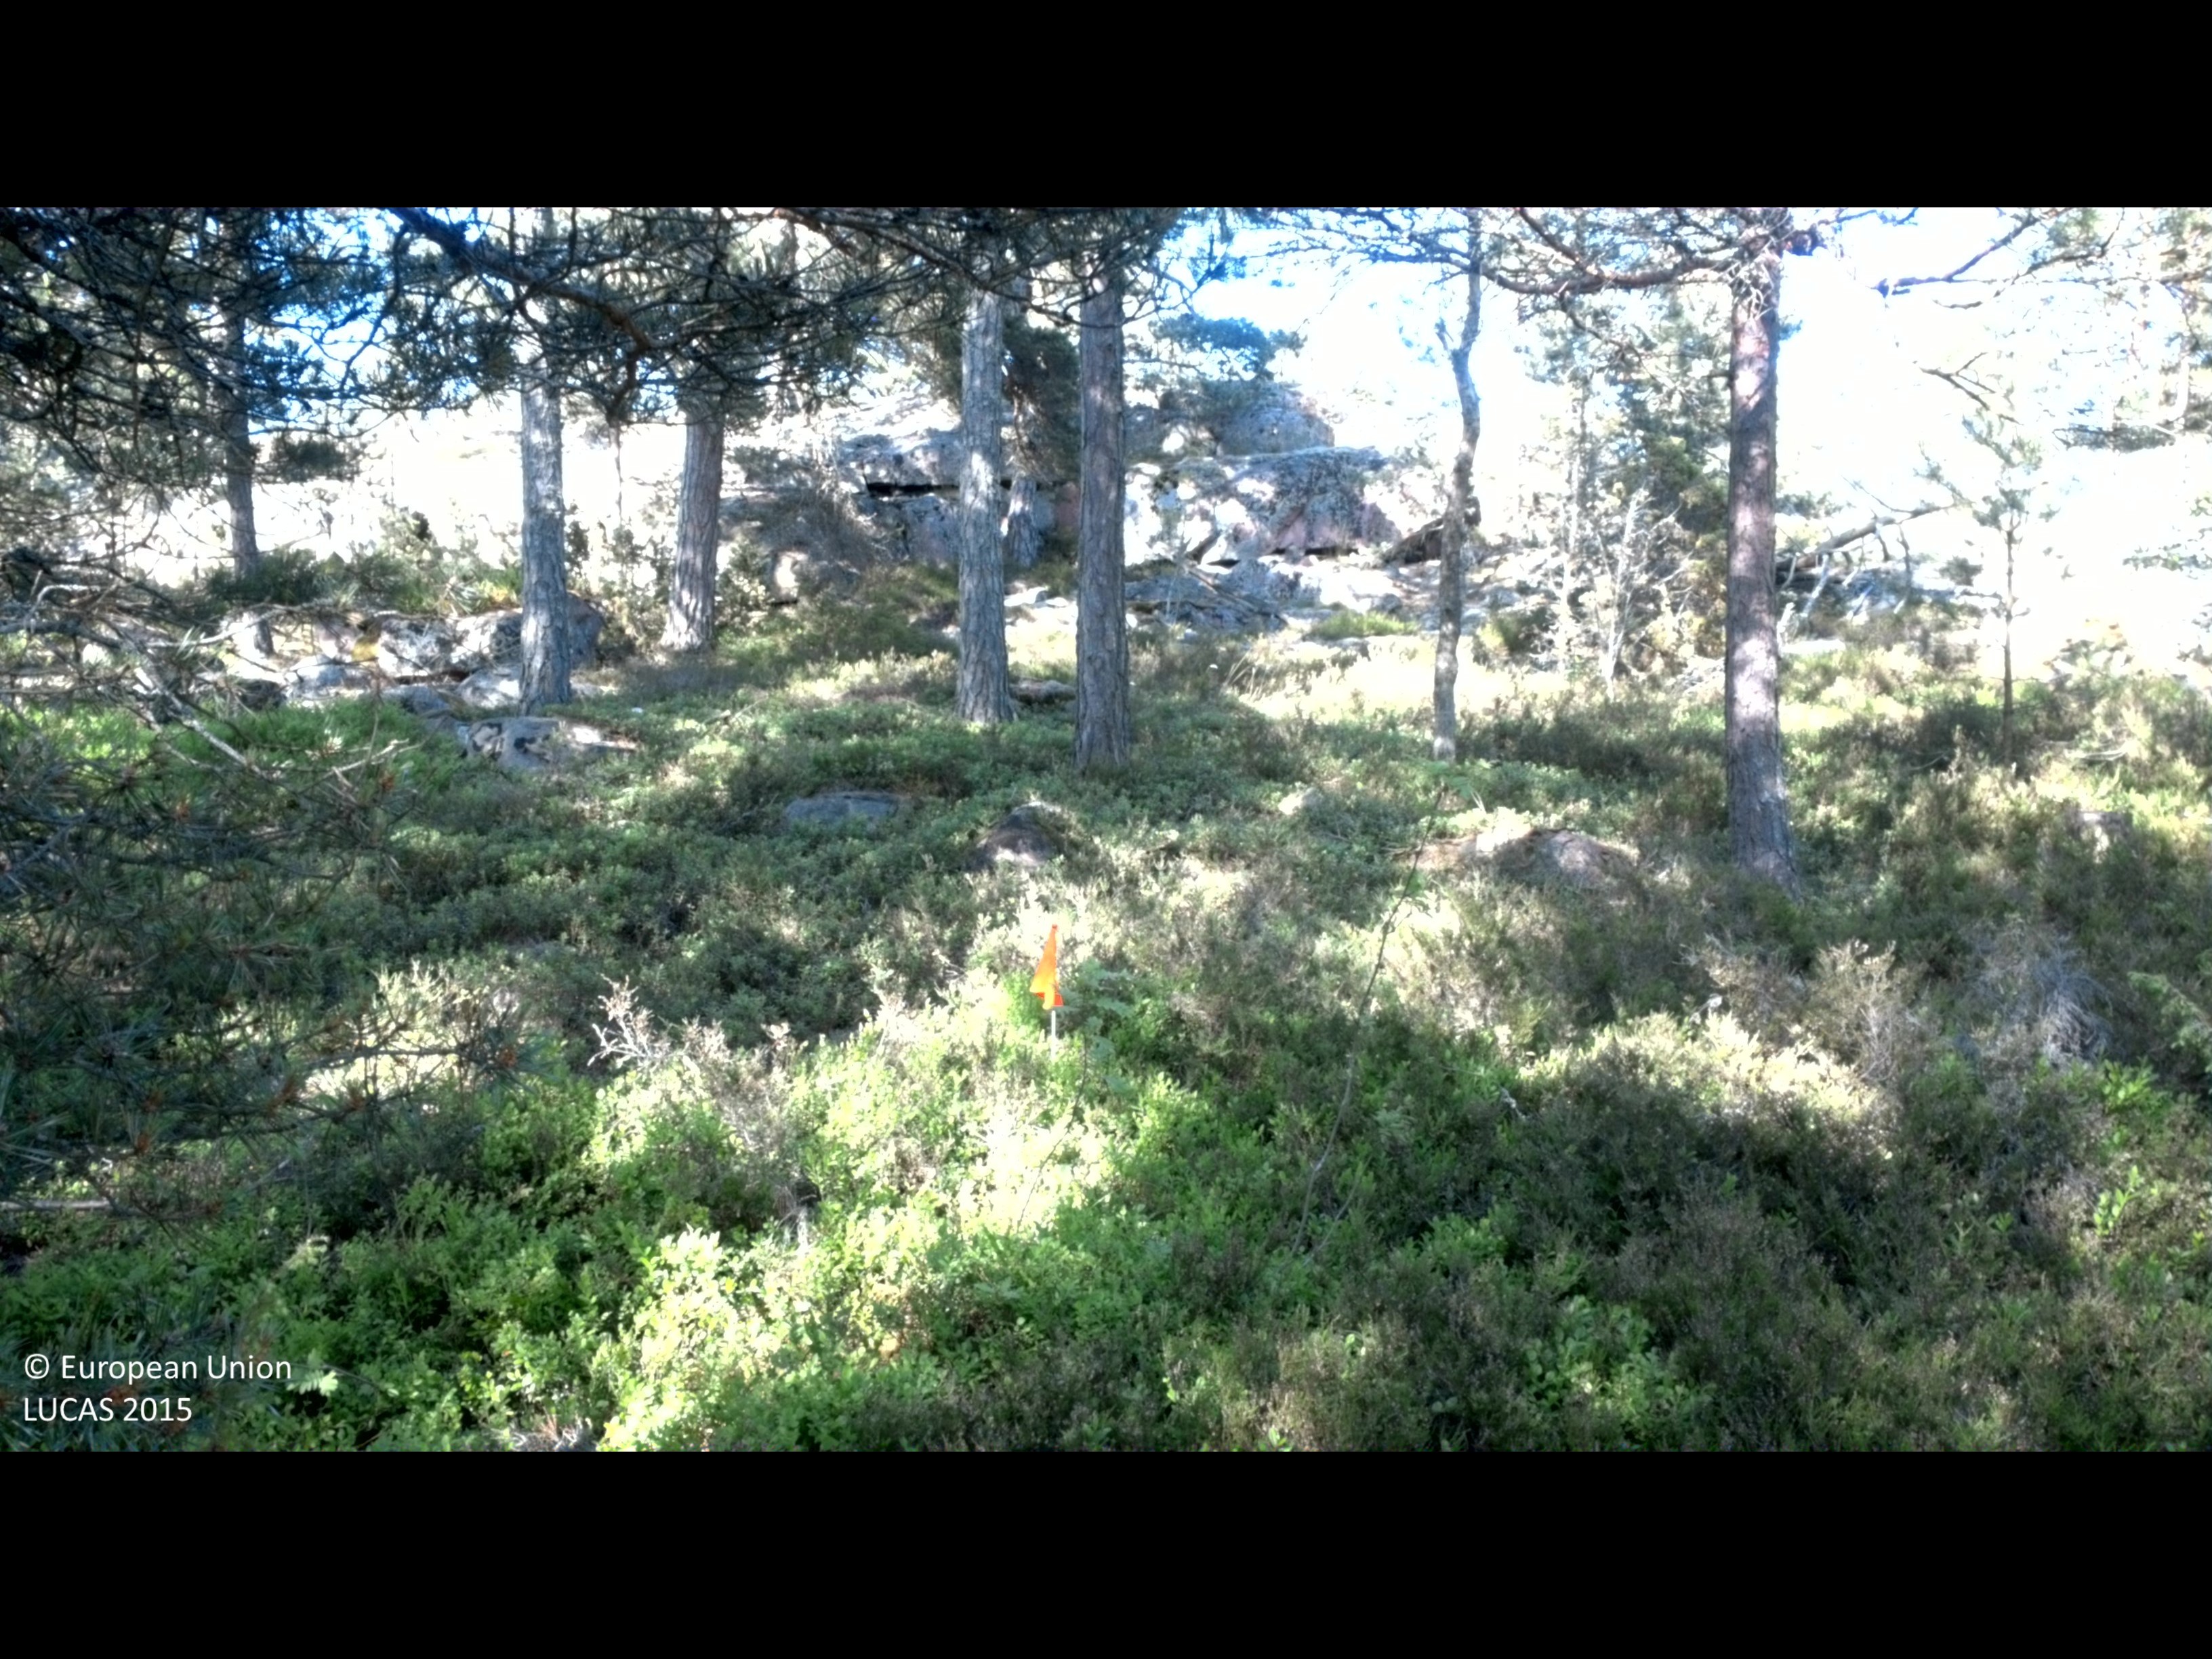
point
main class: Woodland
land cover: Pine dominated coniferous woodland
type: boreal forest
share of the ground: 50 - 75 %
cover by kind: coniferous forest trees 75 %, shrubs 15 %, lichens and mosses 10 %
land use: Forestry
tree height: > 5 m
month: June
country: SE
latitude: 57.8885
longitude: 16.7286
